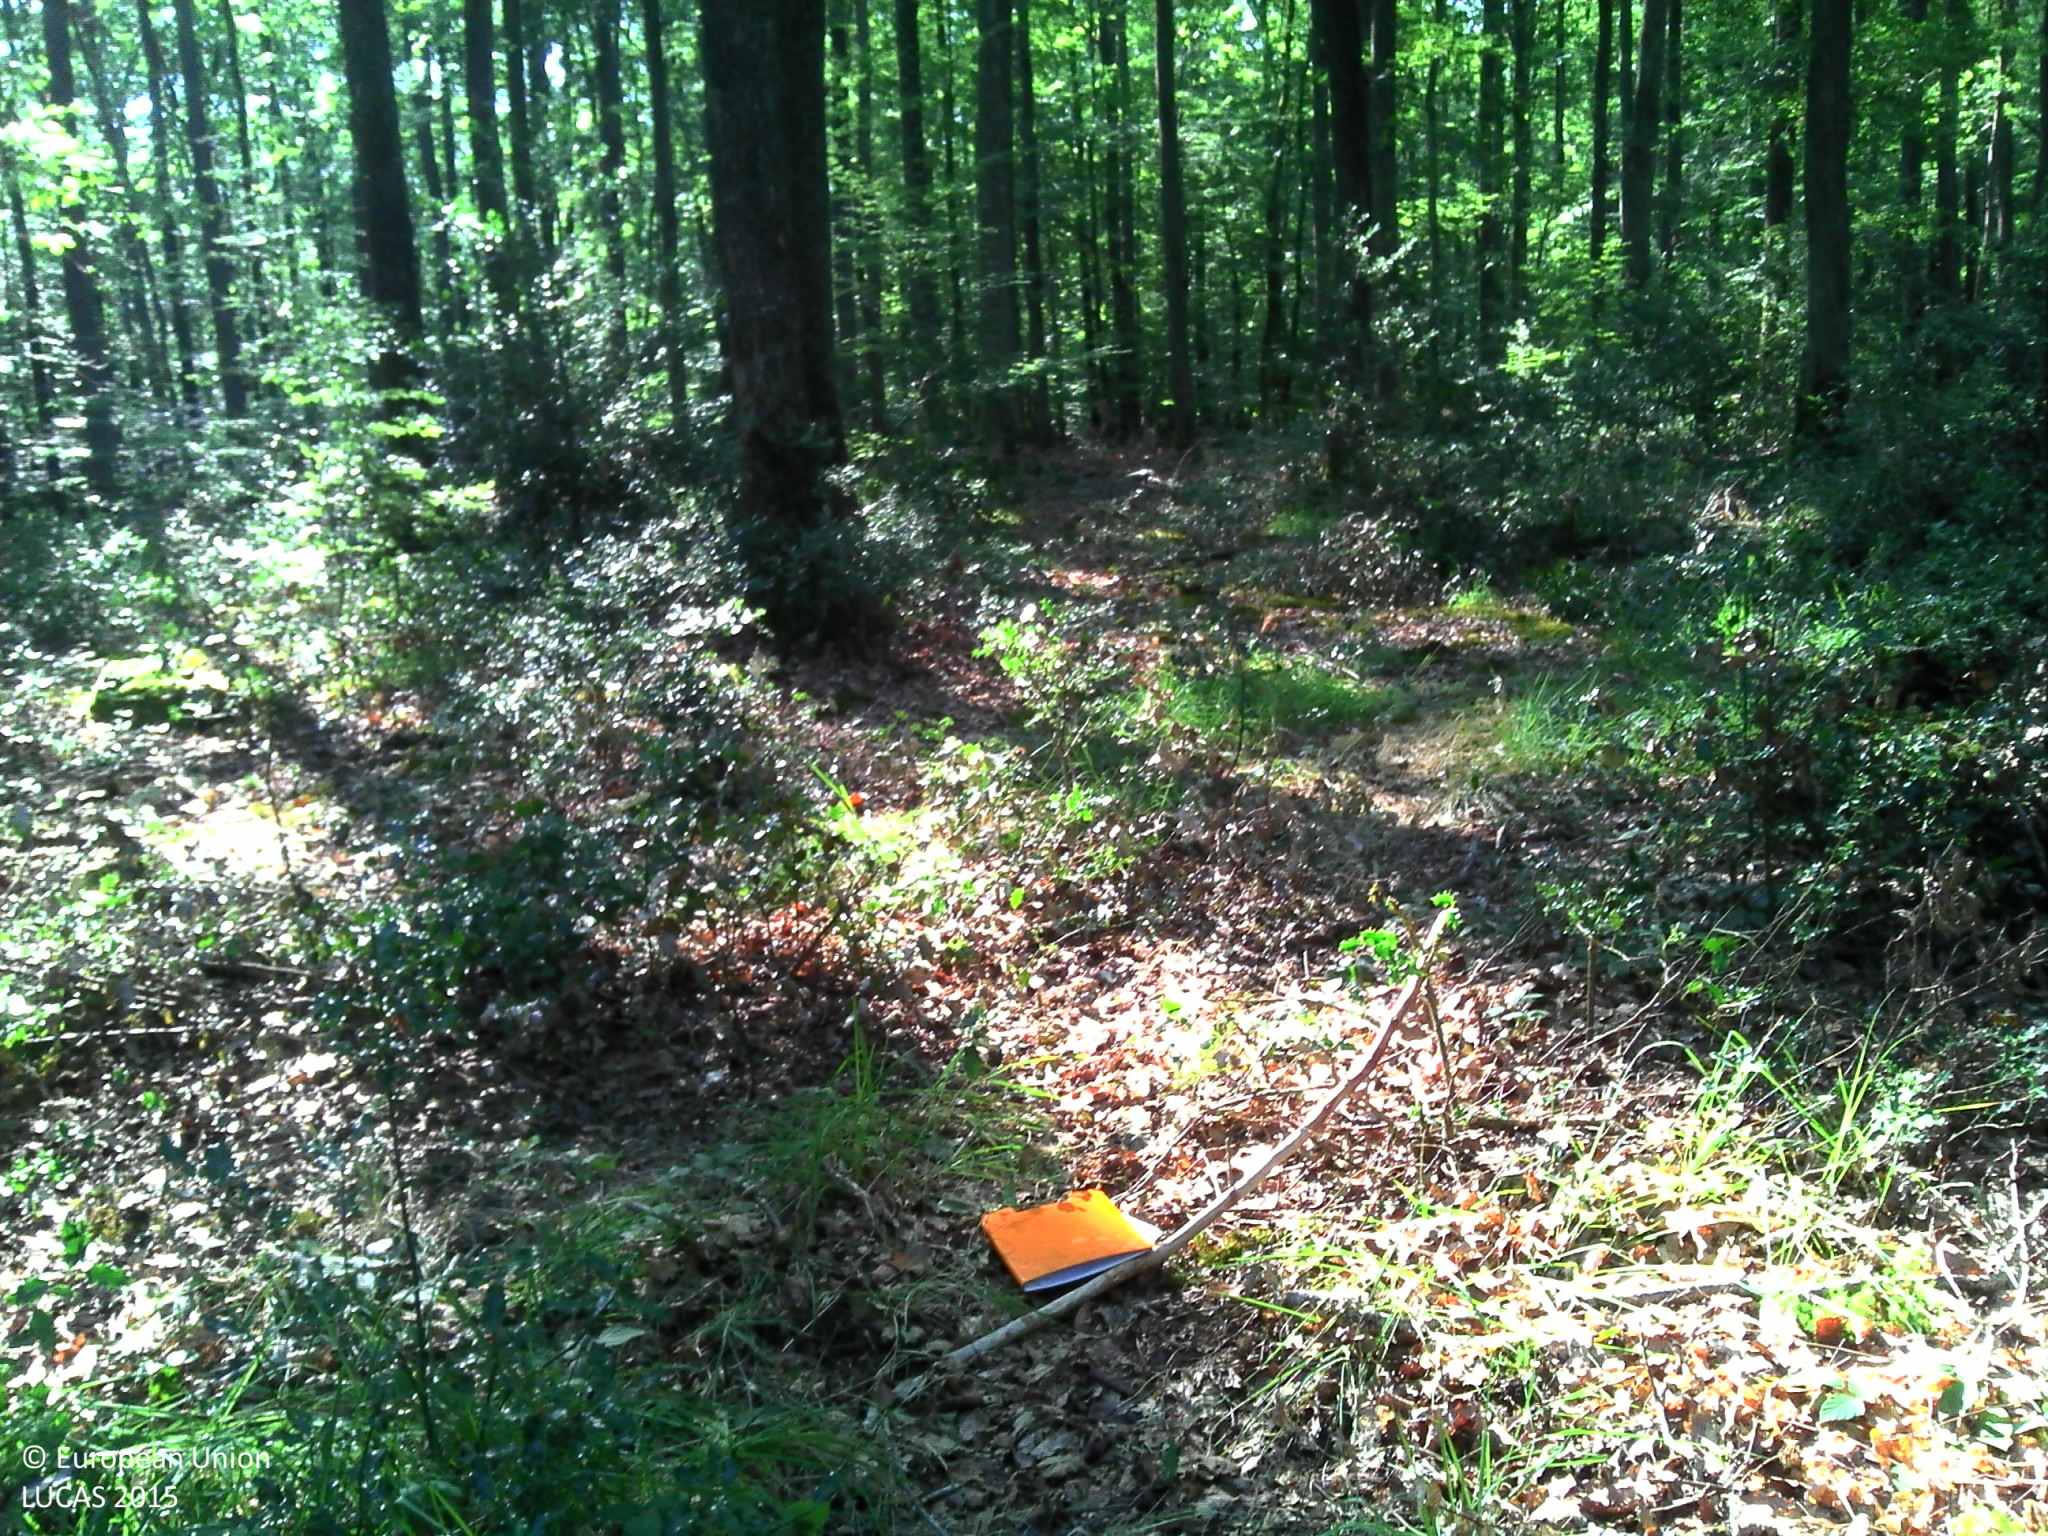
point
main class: Woodland
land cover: Broadleaved woodland
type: mesophytic deciduous forest
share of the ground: > 75 %
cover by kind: broadleaved forest trees 90 %, shrubs 5 %, herbaceous plants 5 %
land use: Forestry
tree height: > 5 m
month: August
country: FR
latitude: 46.6523
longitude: 2.8223
